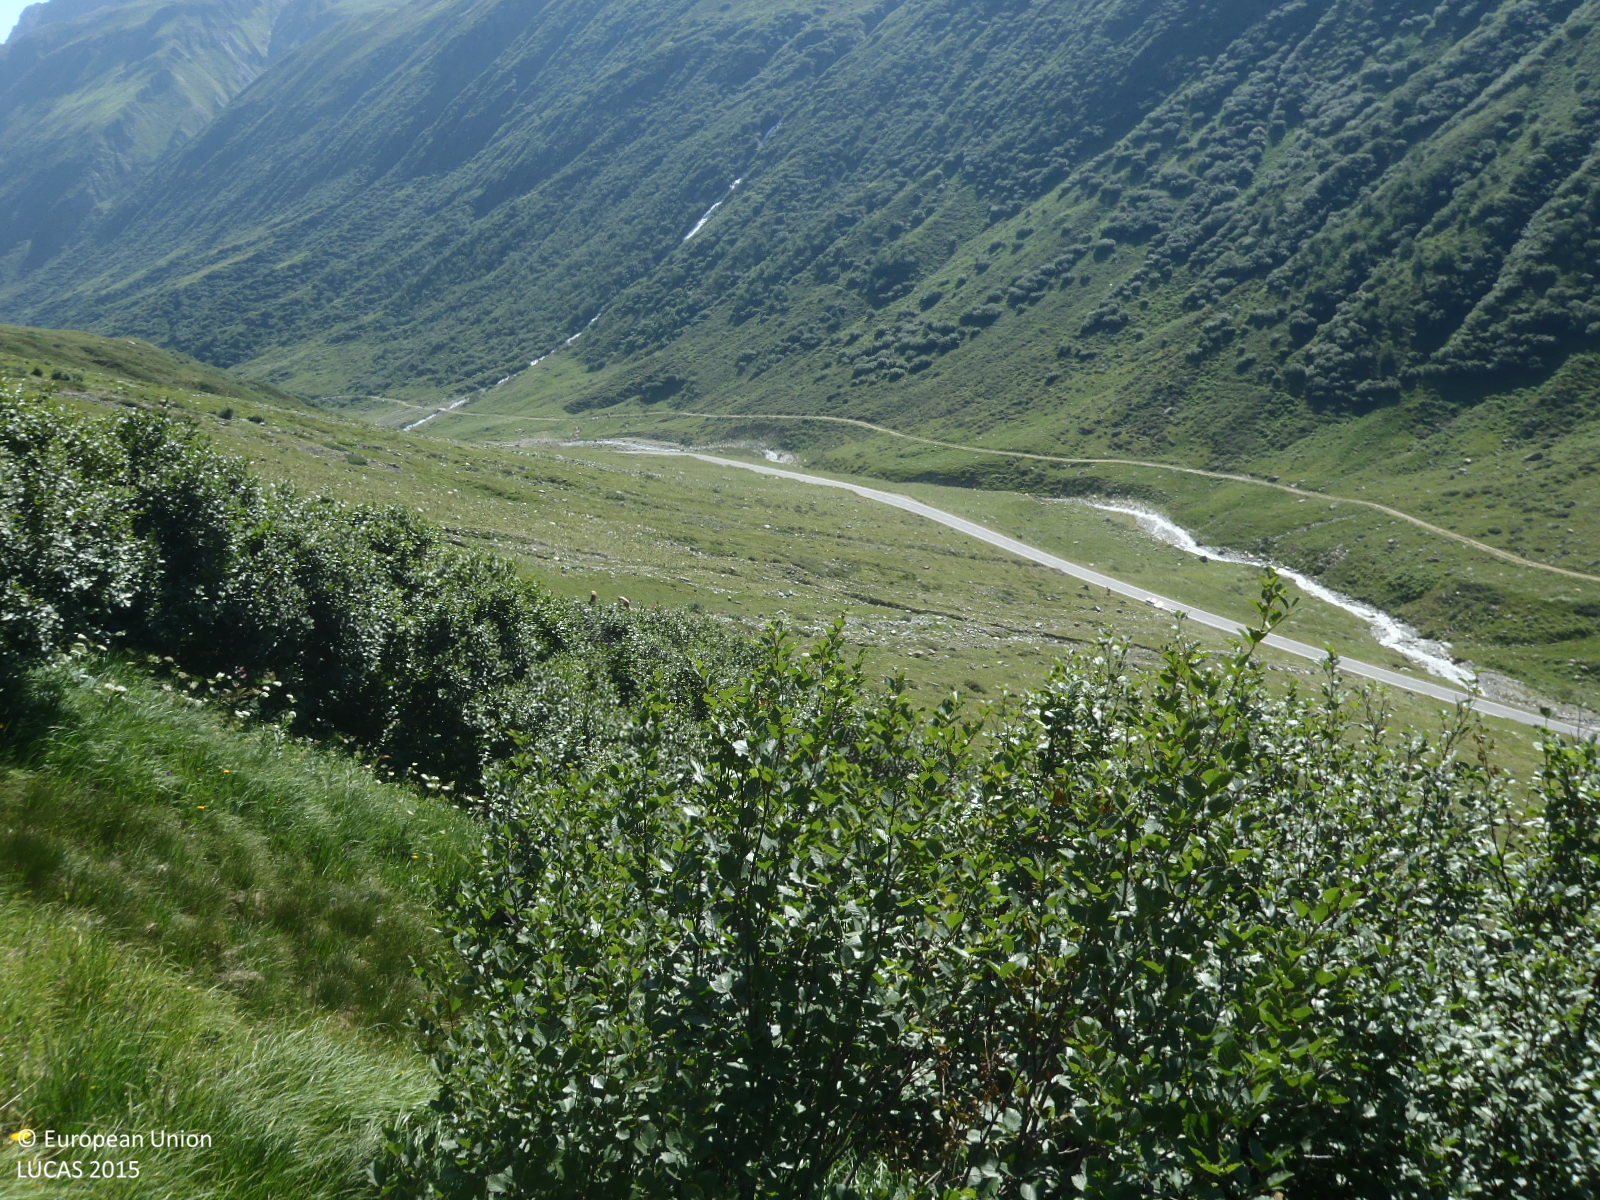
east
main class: Shrubland
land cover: Shrubland without tree cover
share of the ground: 50 - 75 %
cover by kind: shrubs 75 %, herbaceous plants 25 %
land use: Semi-natural and natural areas not in use
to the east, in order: Shrubland without tree cover; Grassland without tree/shrub cover; Shrubland without tree cover; Rocks and stones; Rivers and streams; Rocks and stones; Shrubland without tree cover; Grassland without tree/shrub cover; Shrubland without tree cover; Grassland without tree/shrub cover; Inland marshes; Grassland without tree/shrub cover; Inland marshes; Grassland without tree/shrub cover; Shrubland without tree cover; Grassland without tree/shrub cover; Shrubland without tree cover
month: July
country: AT
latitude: 46.9274
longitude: 10.1181
